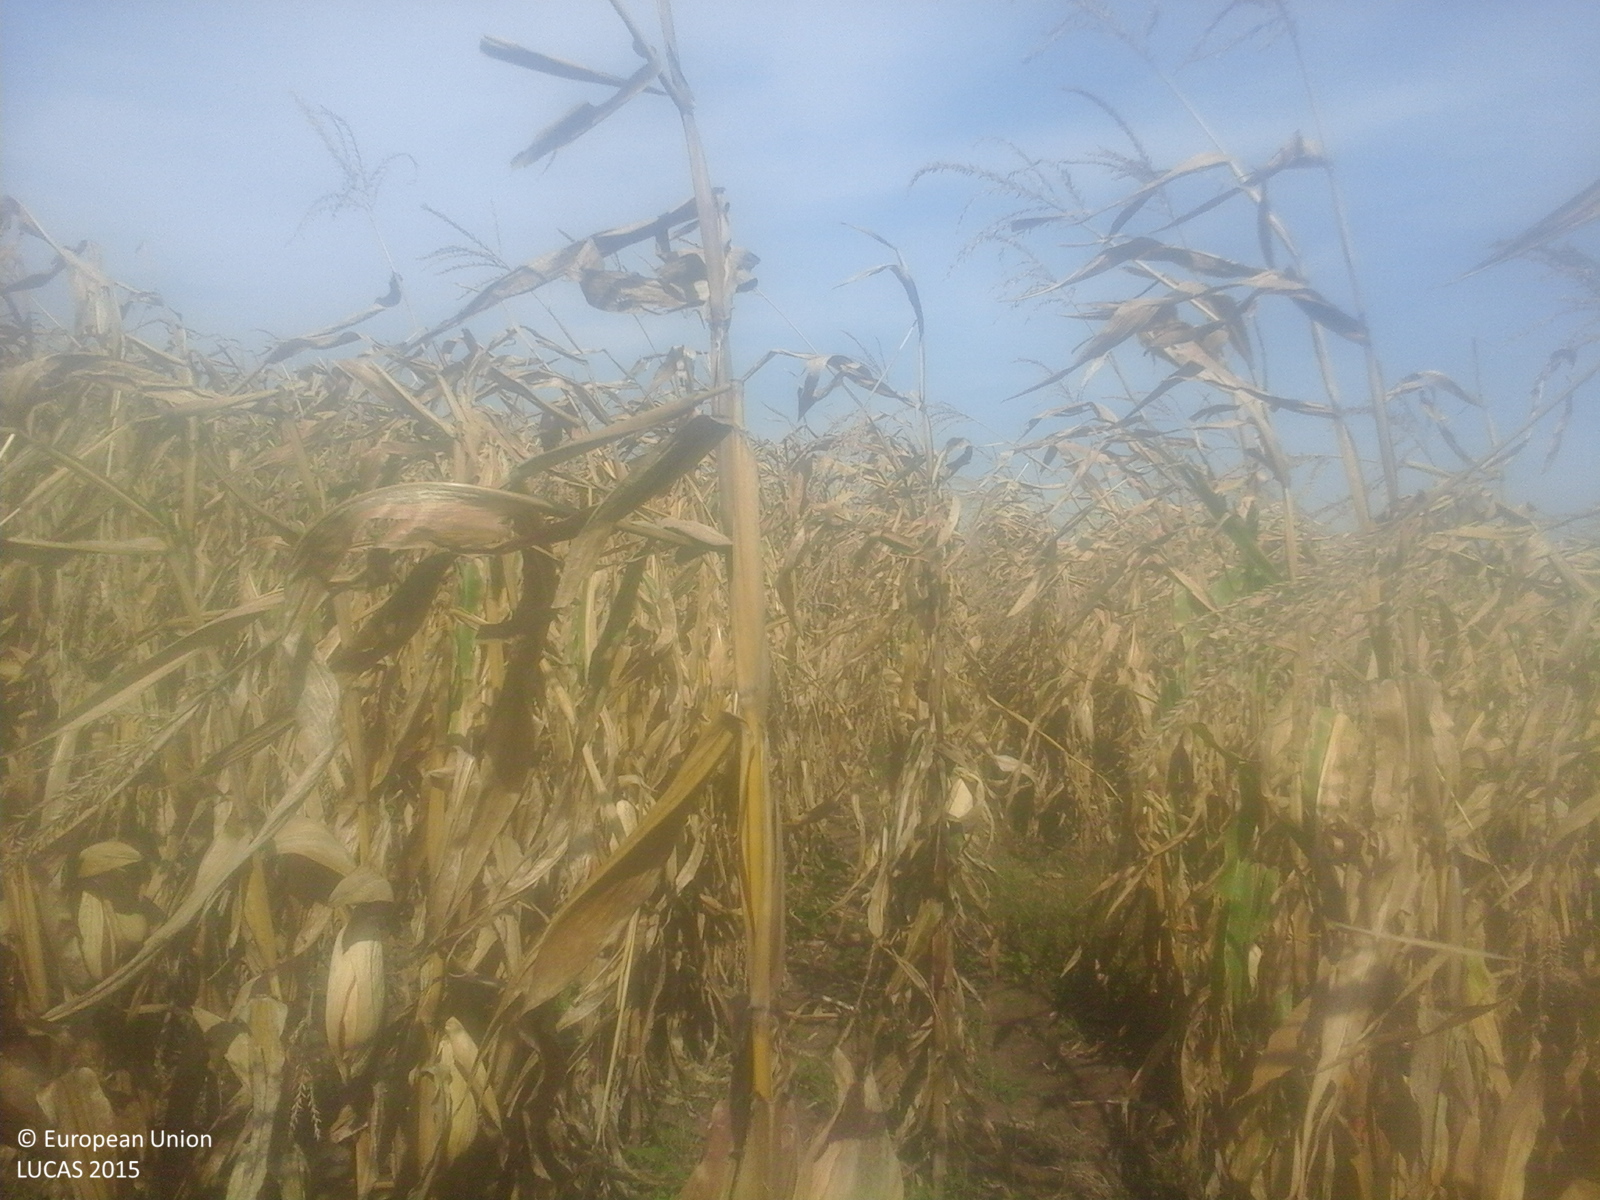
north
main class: Cropland
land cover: Maize
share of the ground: > 75 %
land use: Agriculture (excluding fallow land and kitchen gardens)
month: September
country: RO
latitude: 46.9614
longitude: 23.7022
